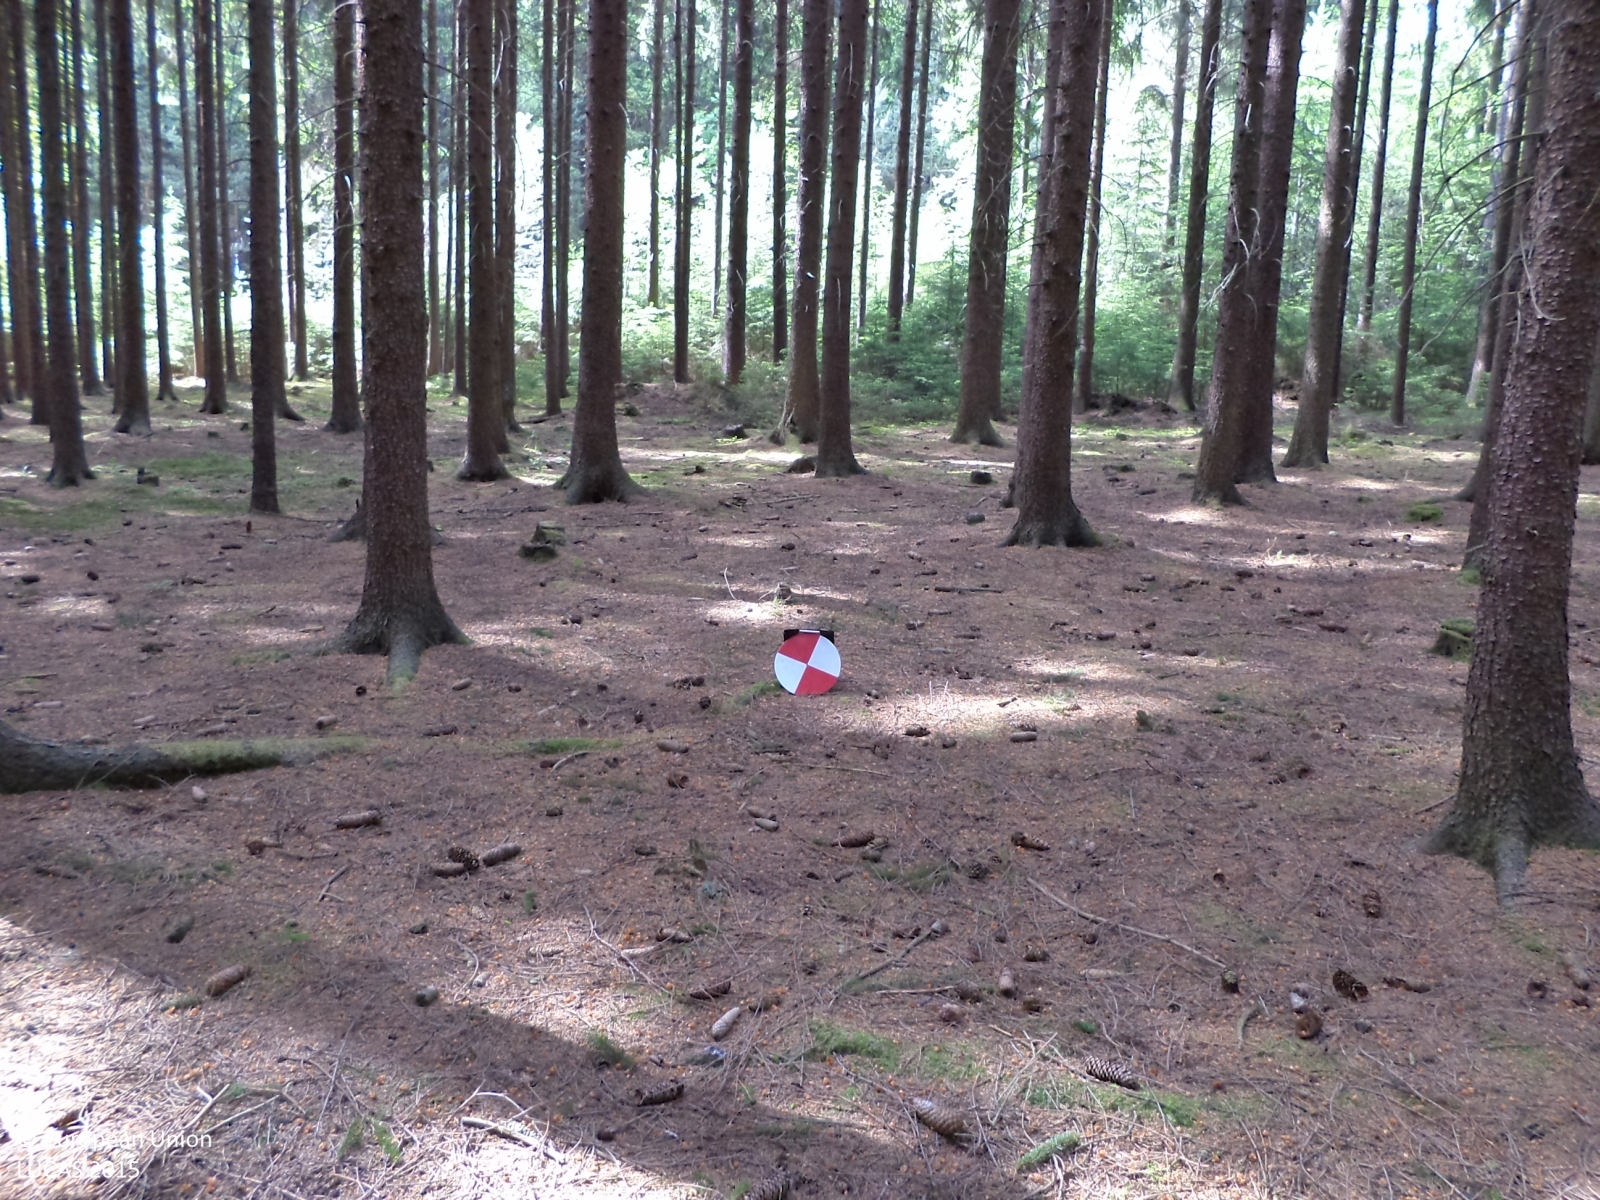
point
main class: Woodland
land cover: Spruce dominated coniferous woodland
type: hemiboreal forest and nemoral coniferous forest and mixed broadleaved-coniferous forest
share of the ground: > 75 %
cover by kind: coniferous forest trees 95 %, lichens and mosses 5 %
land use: Forestry
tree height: > 5 m
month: June
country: CZ
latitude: 49.6192
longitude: 15.1104
